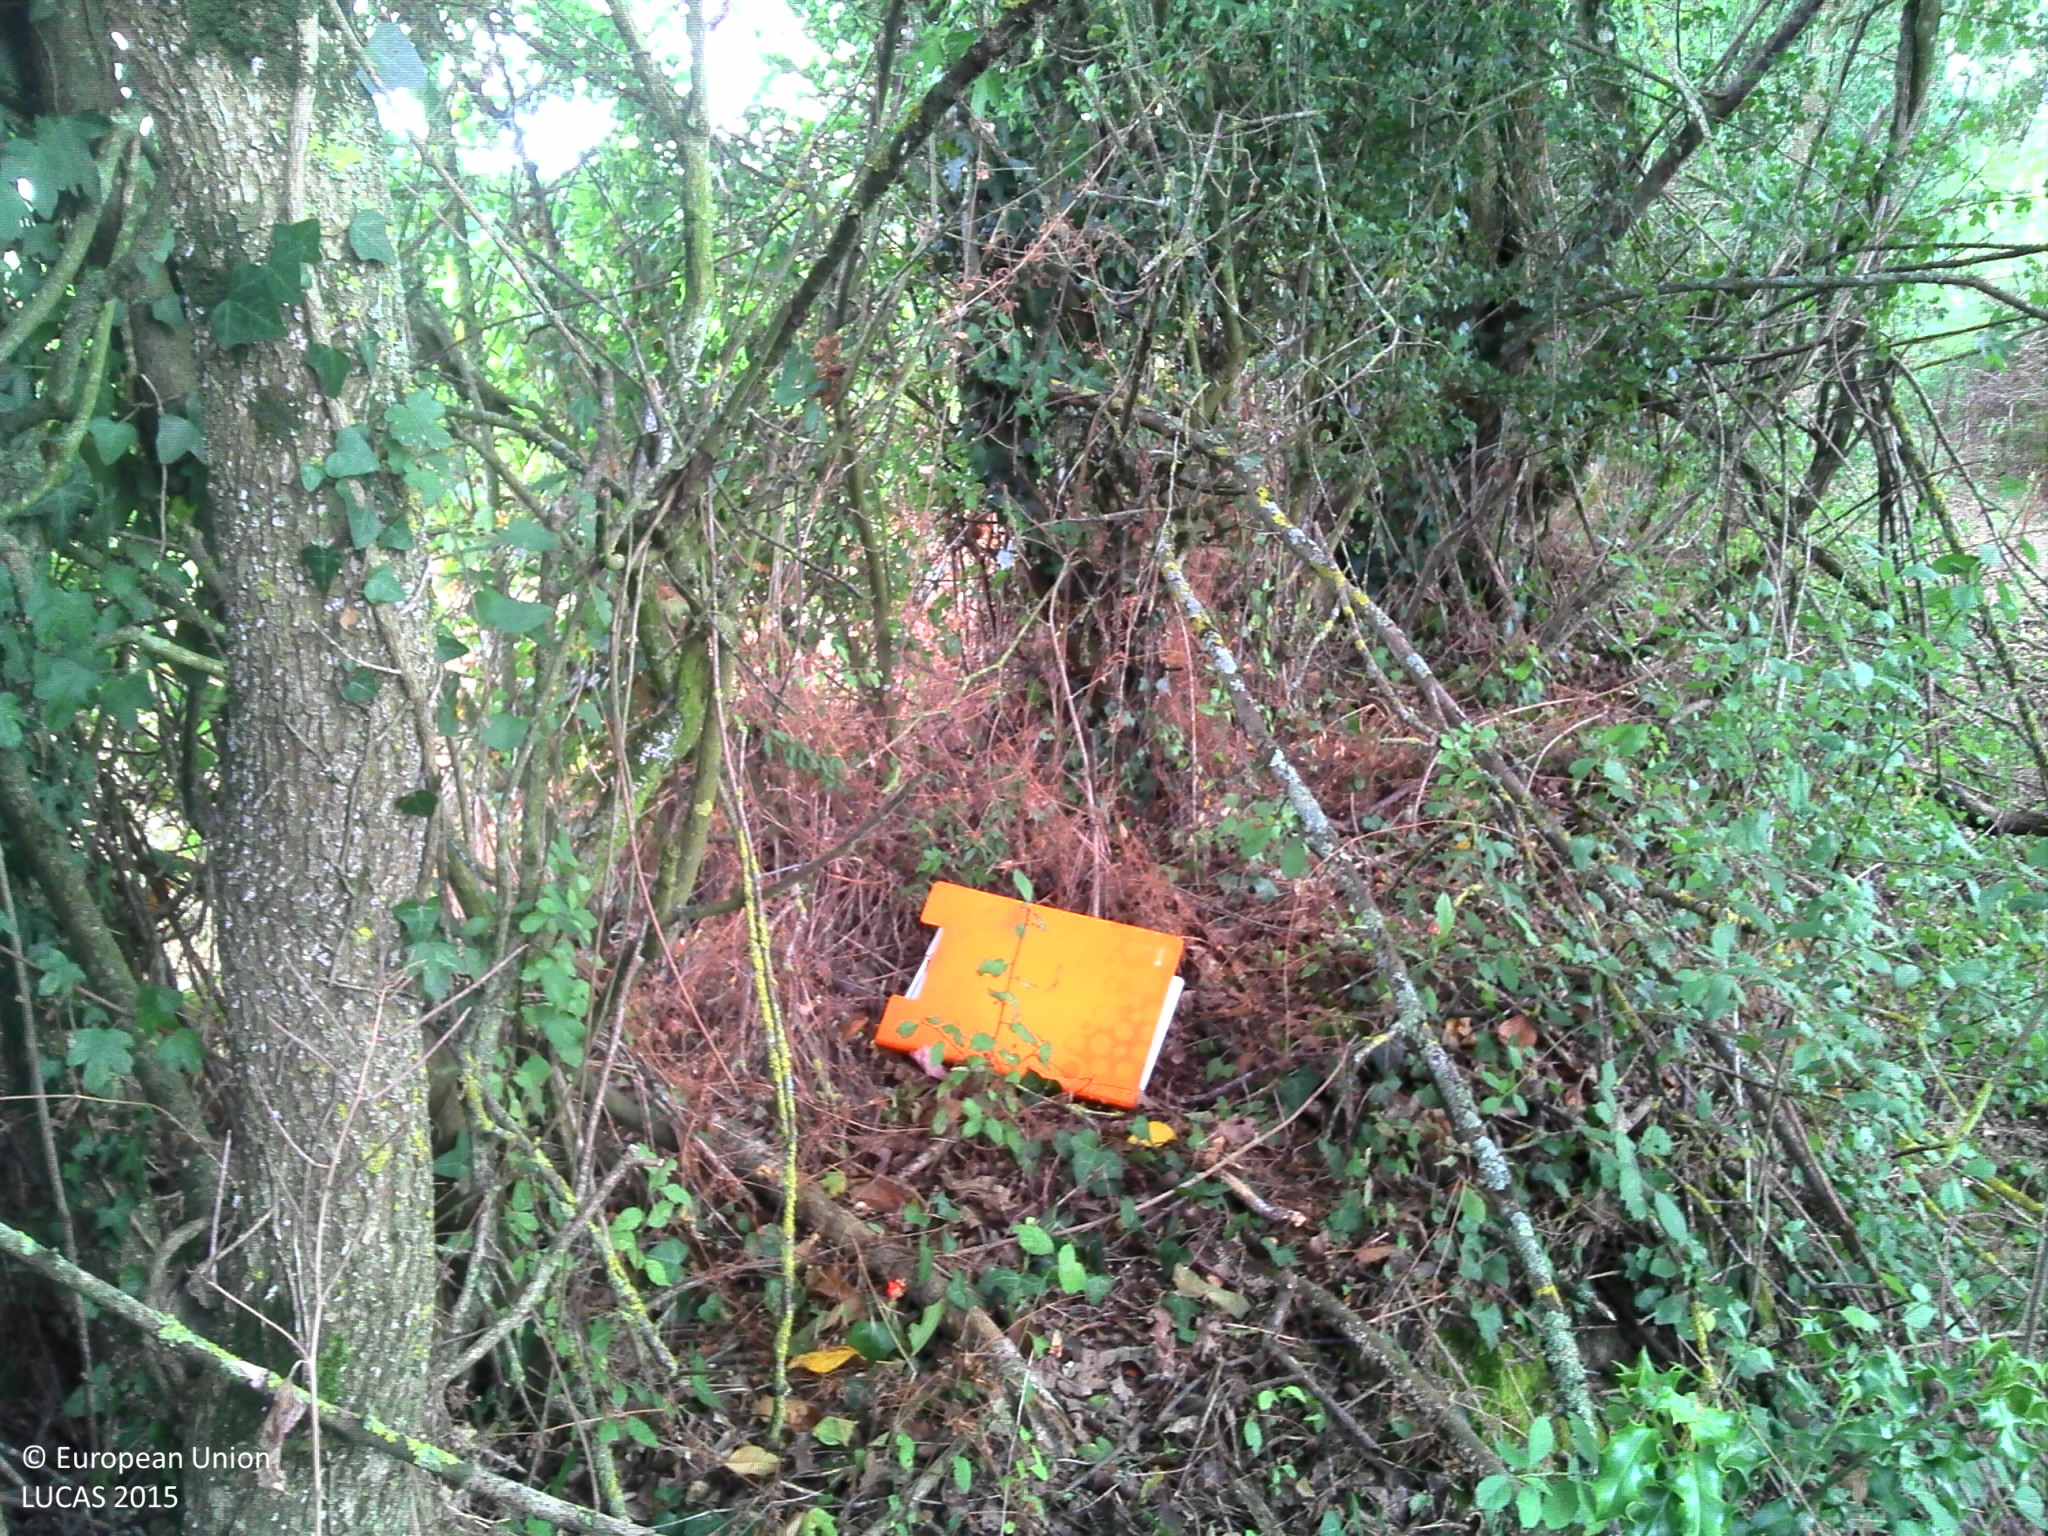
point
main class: Woodland
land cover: Broadleaved woodland
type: mesophytic deciduous forest
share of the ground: > 75 %
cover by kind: broadleaved forest trees 100 %
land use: Agriculture (excluding fallow land and kitchen gardens)
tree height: > 5 m
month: July
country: FR
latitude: 46.6963
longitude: 2.1594
